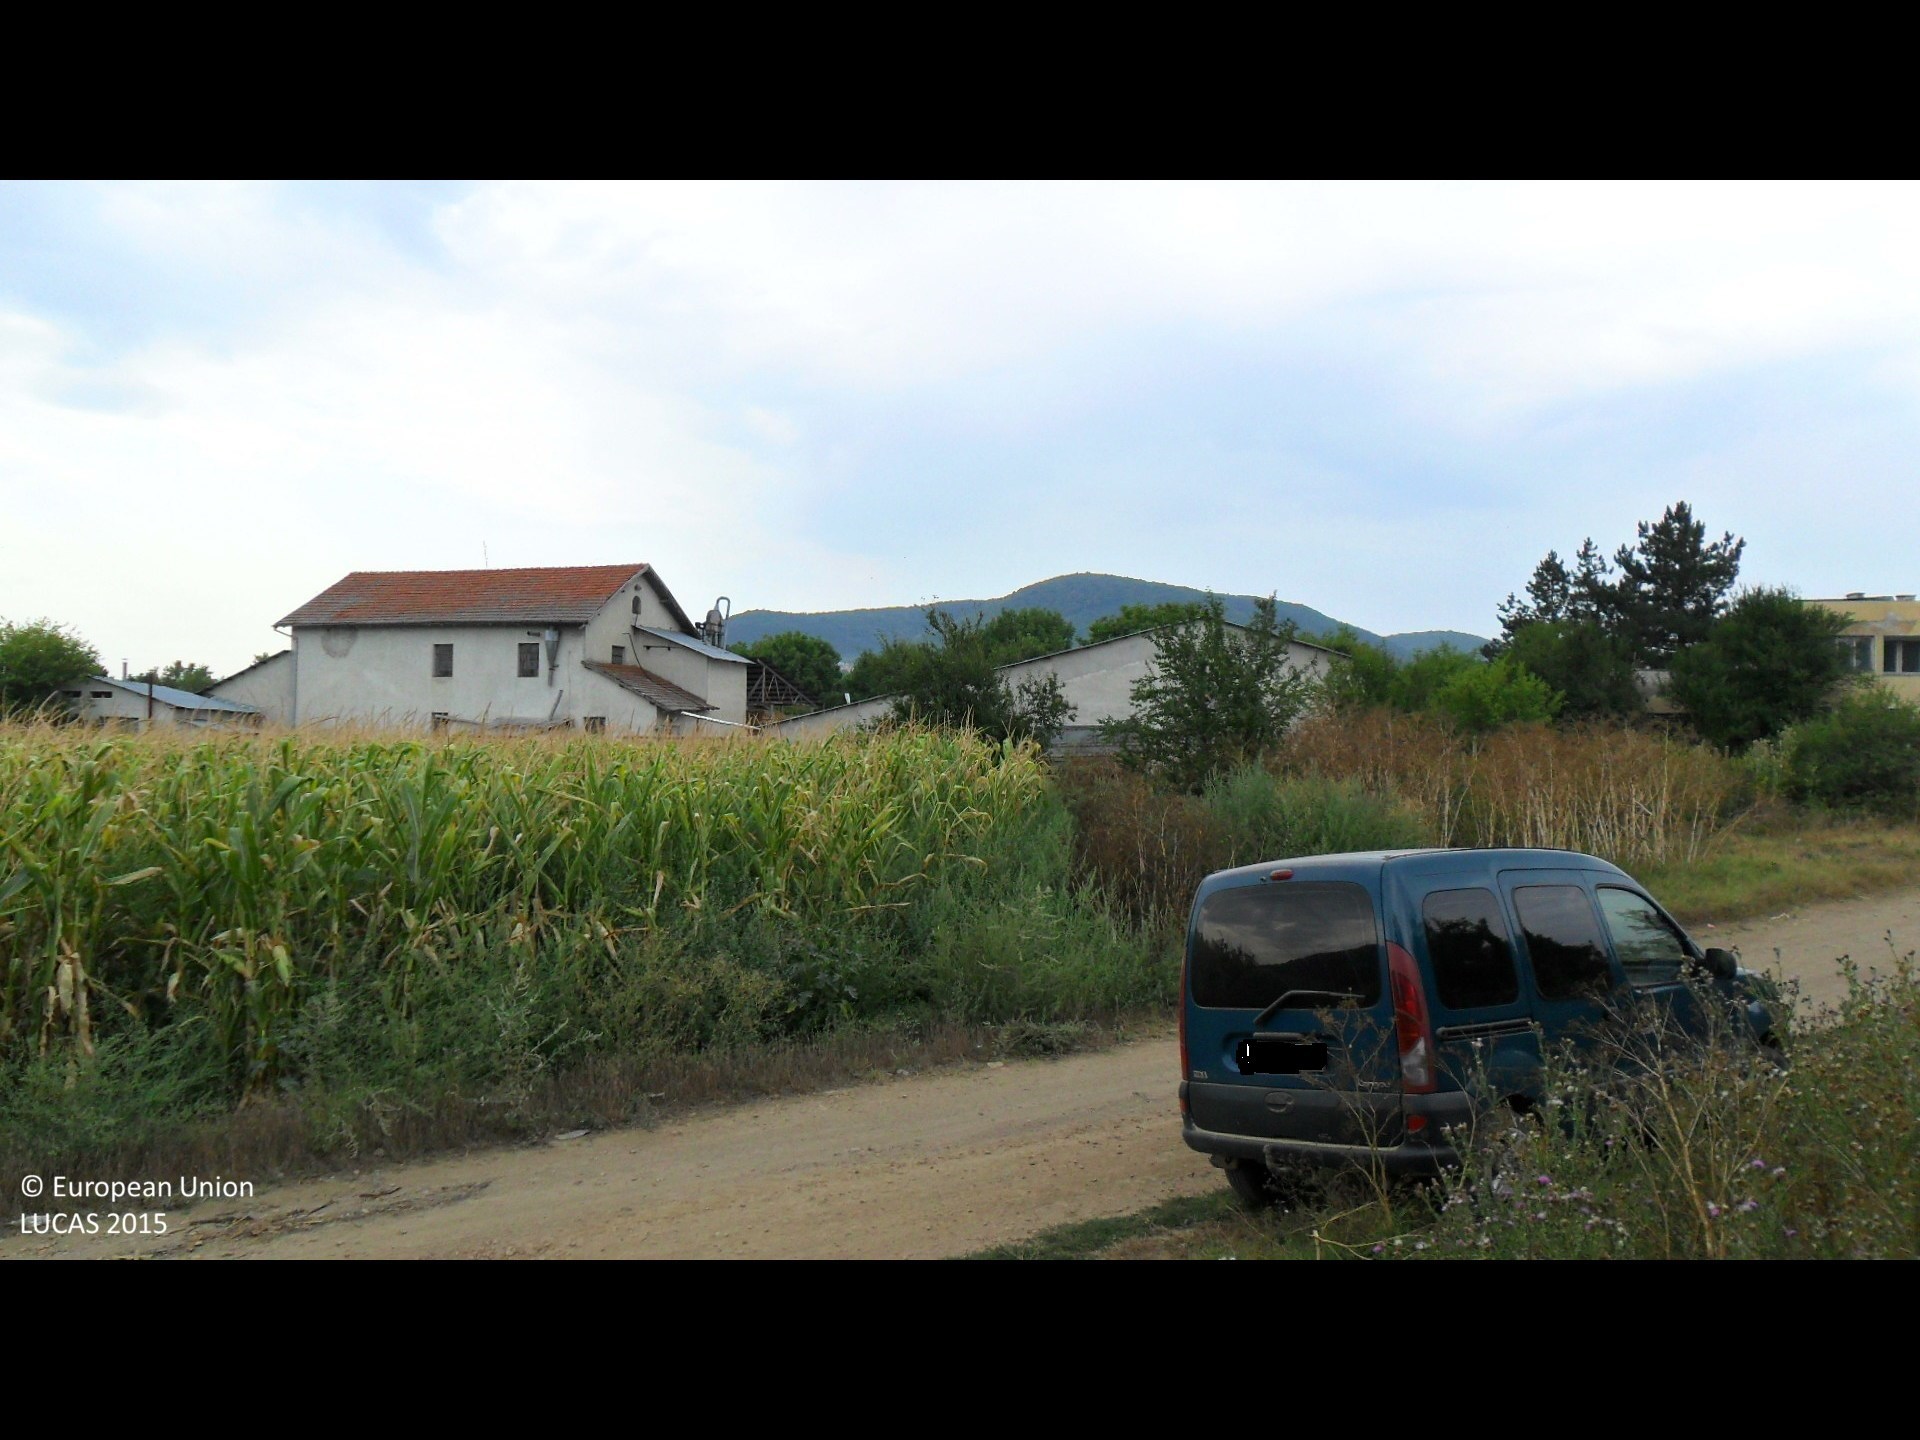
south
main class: Shrubland
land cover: Shrubland with sparse tree cover
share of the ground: > 75 %
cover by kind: shrubs 95 %, broadleaved forest trees 5 %
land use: Semi-natural and natural areas not in use
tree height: < 5 m
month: August
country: BG
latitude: 43.4571
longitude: 26.1750
